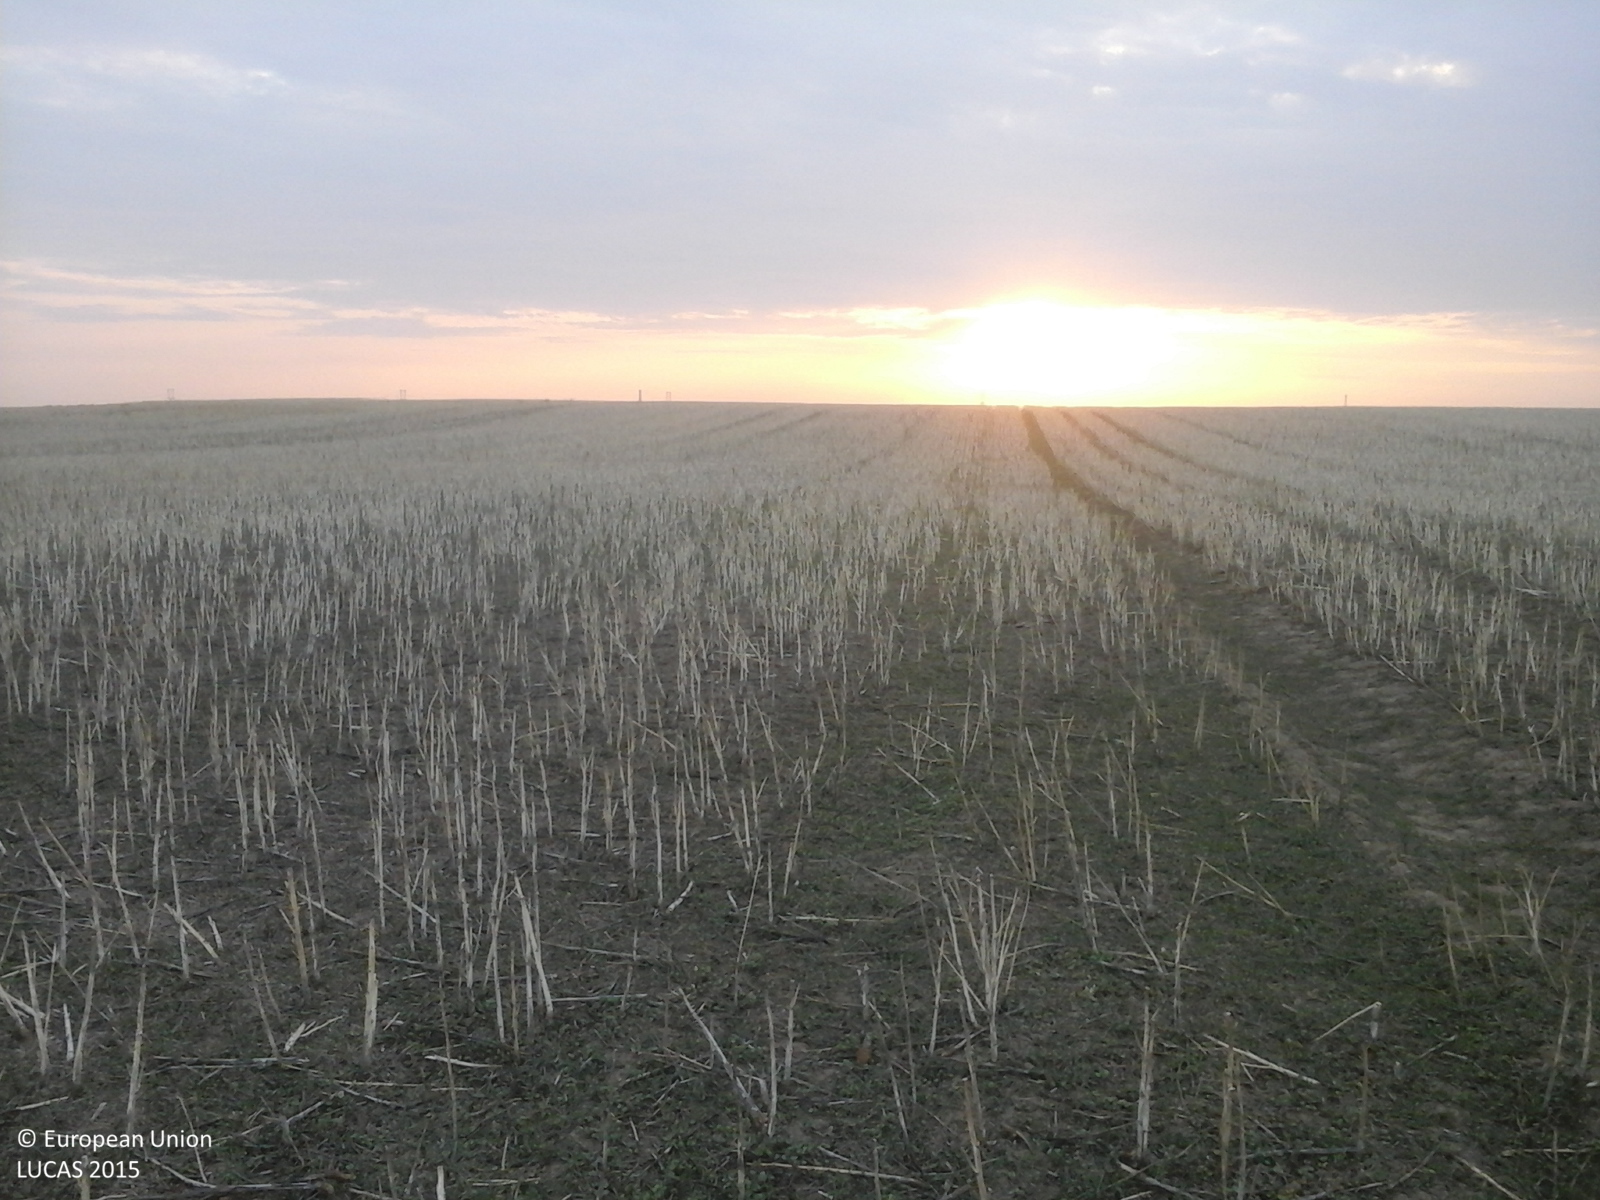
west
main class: Cropland
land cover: Rape and turnip rape
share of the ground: 10 - 25 %
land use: Agriculture (excluding fallow land and kitchen gardens)
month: August
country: RO
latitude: 46.2270
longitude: 21.4322
